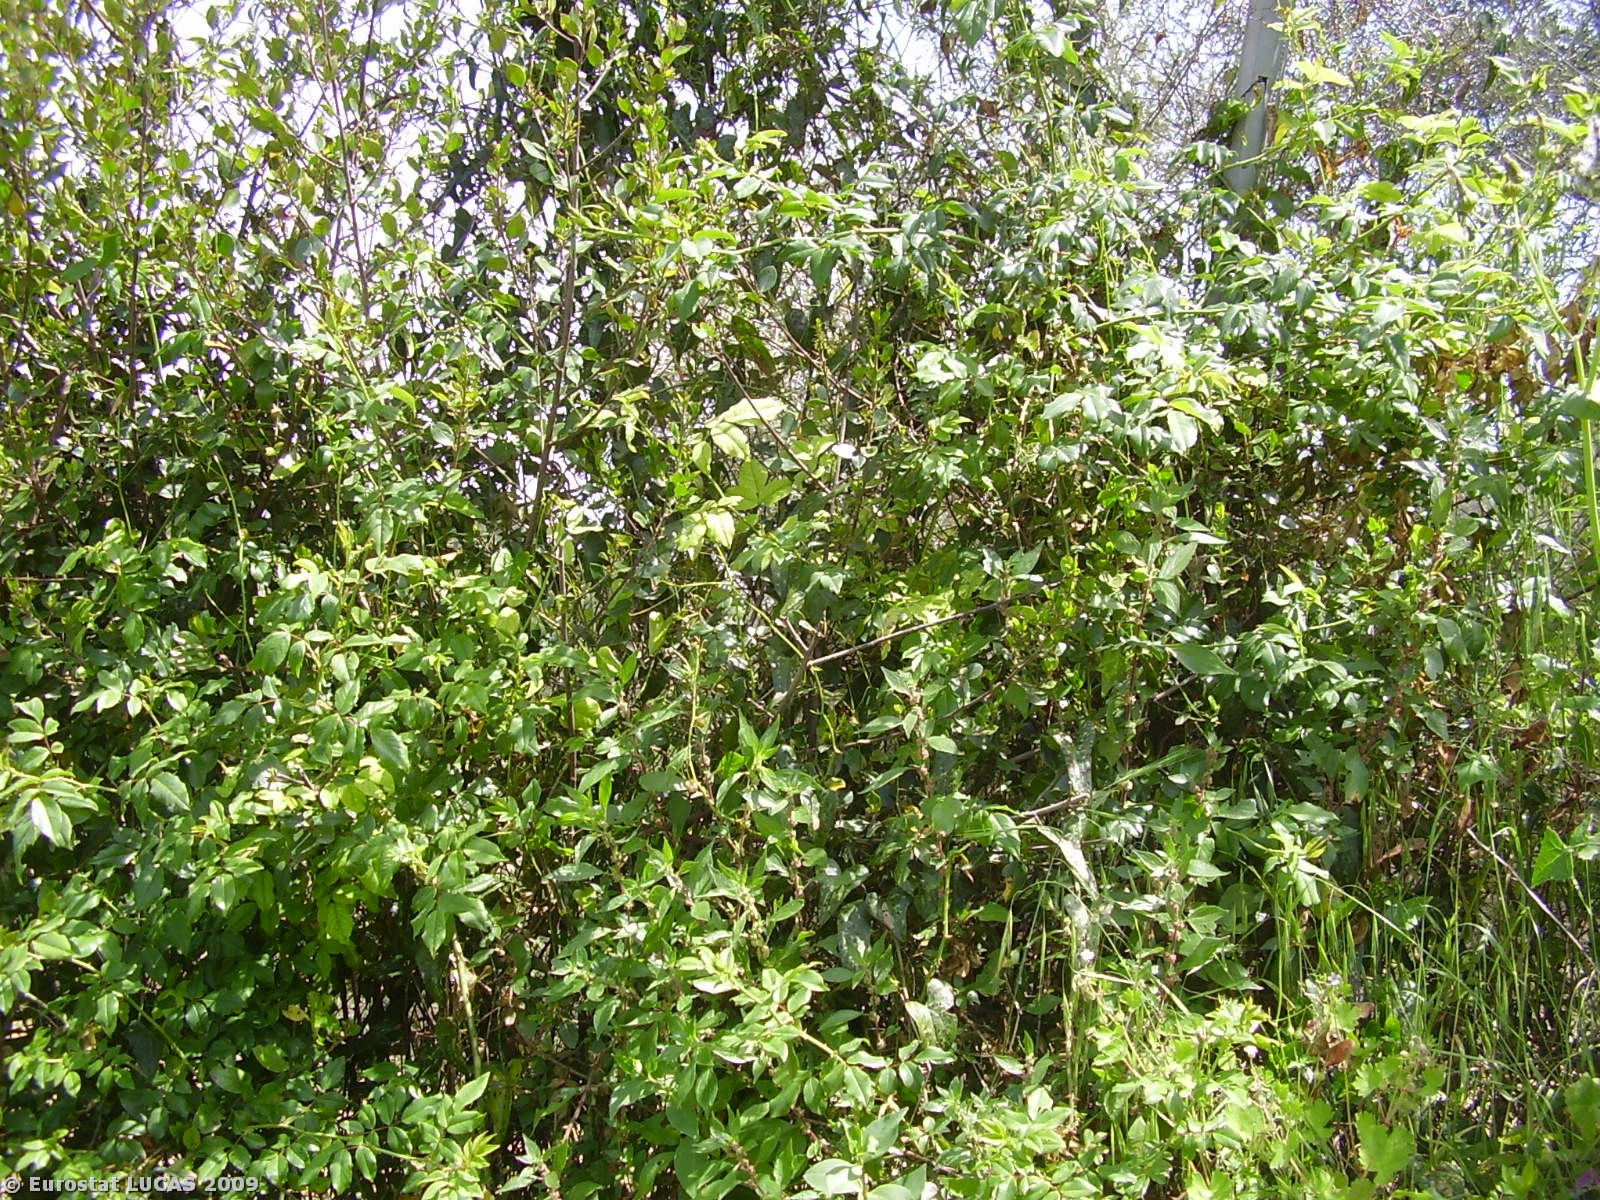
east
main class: Shrubland
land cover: Shrubland with sparse tree cover
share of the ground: 50 - 75 %
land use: Agriculture (excluding fallow land and kitchen gardens)
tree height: < 5 m
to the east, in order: Shrubland with sparse tree cover; Artificial constructions in urban areas; Spontaneously vegetated surfaces; Olive groves; Spontaneously vegetated surfaces; Fences; Dry stone walls; Olive groves; Spontaneously vegetated surfaces; Dry stone walls; Olive groves; Spontaneously vegetated surfaces; Dry stone walls; Olive groves; Spontaneously vegetated surfaces; Dry stone walls; Spontaneously vegetated surfaces; Dry stone walls; Olive groves; Spontaneously vegetated surfaces; Tracks; Dry stone walls; Single bushes/trees; Grass margins; Dry stone walls; Paved roads, cycling and walking lanes; Grass margins; Conifer hedges; Fences; Dry stone walls; Olive groves; Spontaneously vegetated surfaces
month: May
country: IT
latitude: 37.1276
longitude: 14.9485
